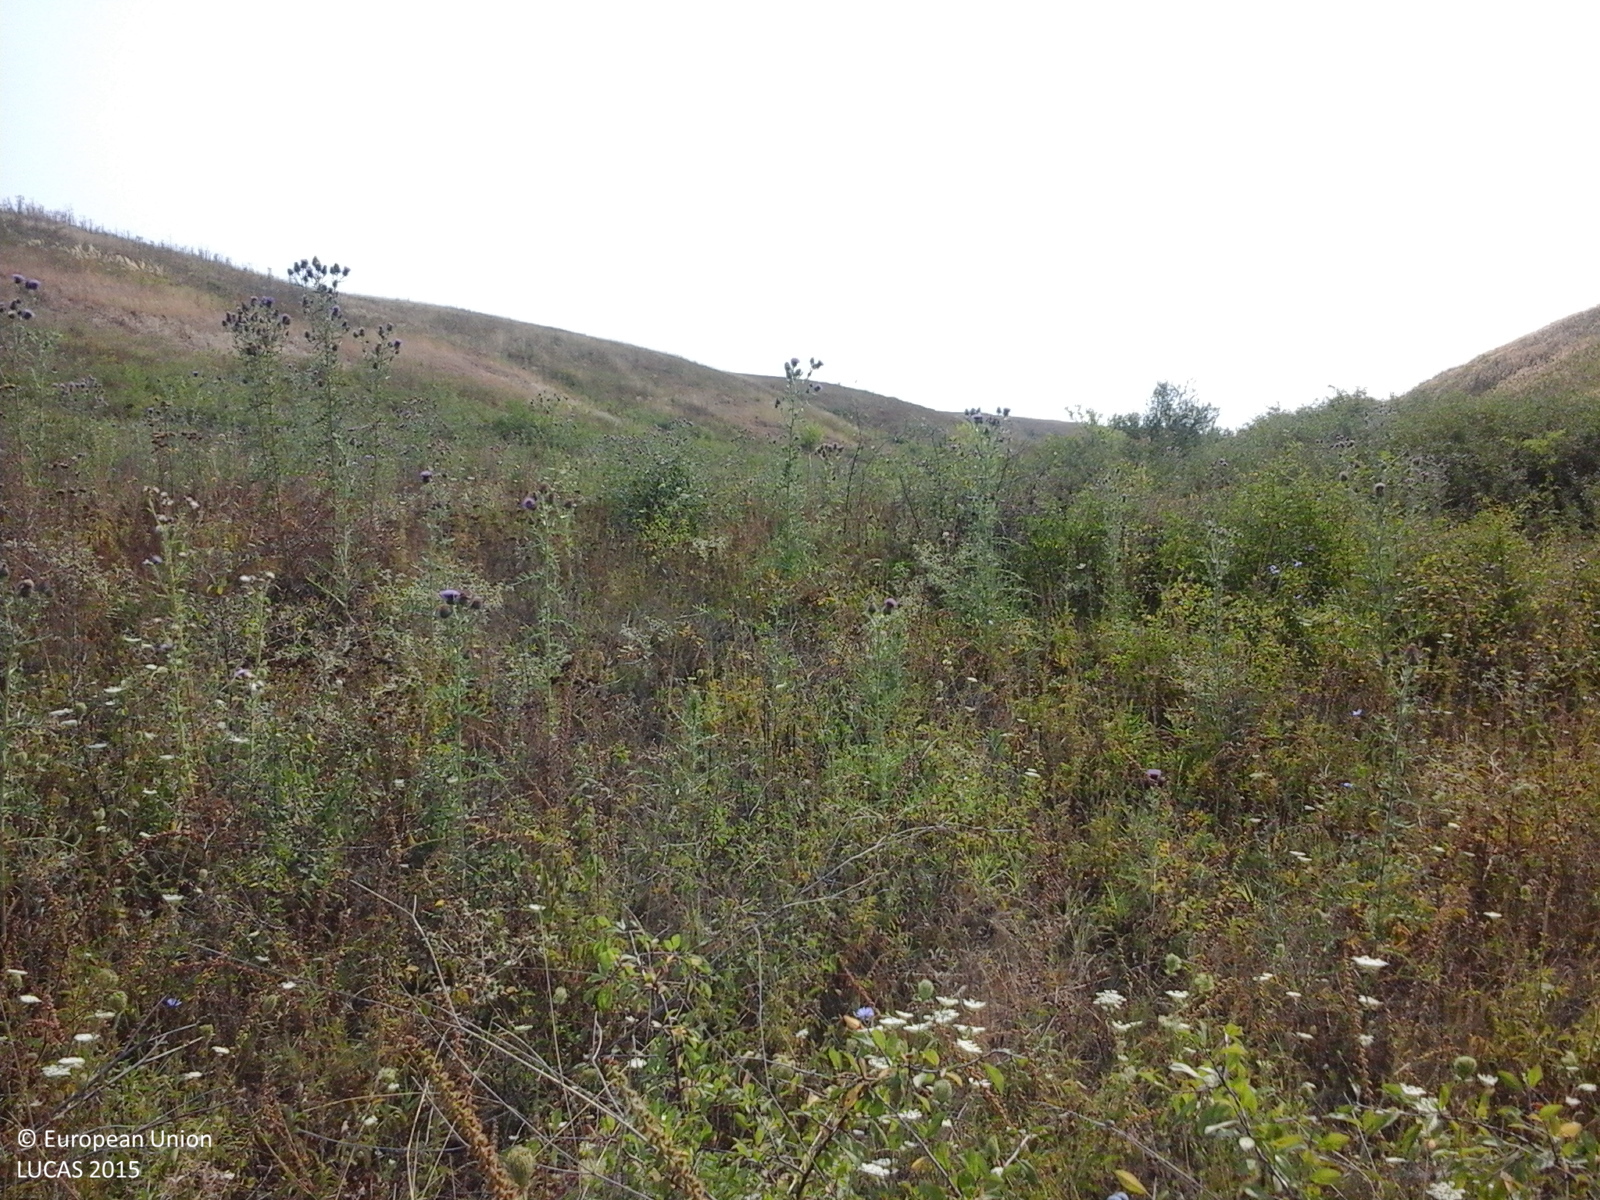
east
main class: Grassland
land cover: Spontaneously vegetated surfaces
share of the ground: > 75 %
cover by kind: herbaceous plants 100 %
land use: Fallow land
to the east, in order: Spontaneously vegetated surfaces; Shrubland without tree cover; Spontaneously vegetated surfaces
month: August
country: RO
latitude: 44.4824
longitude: 23.3916
